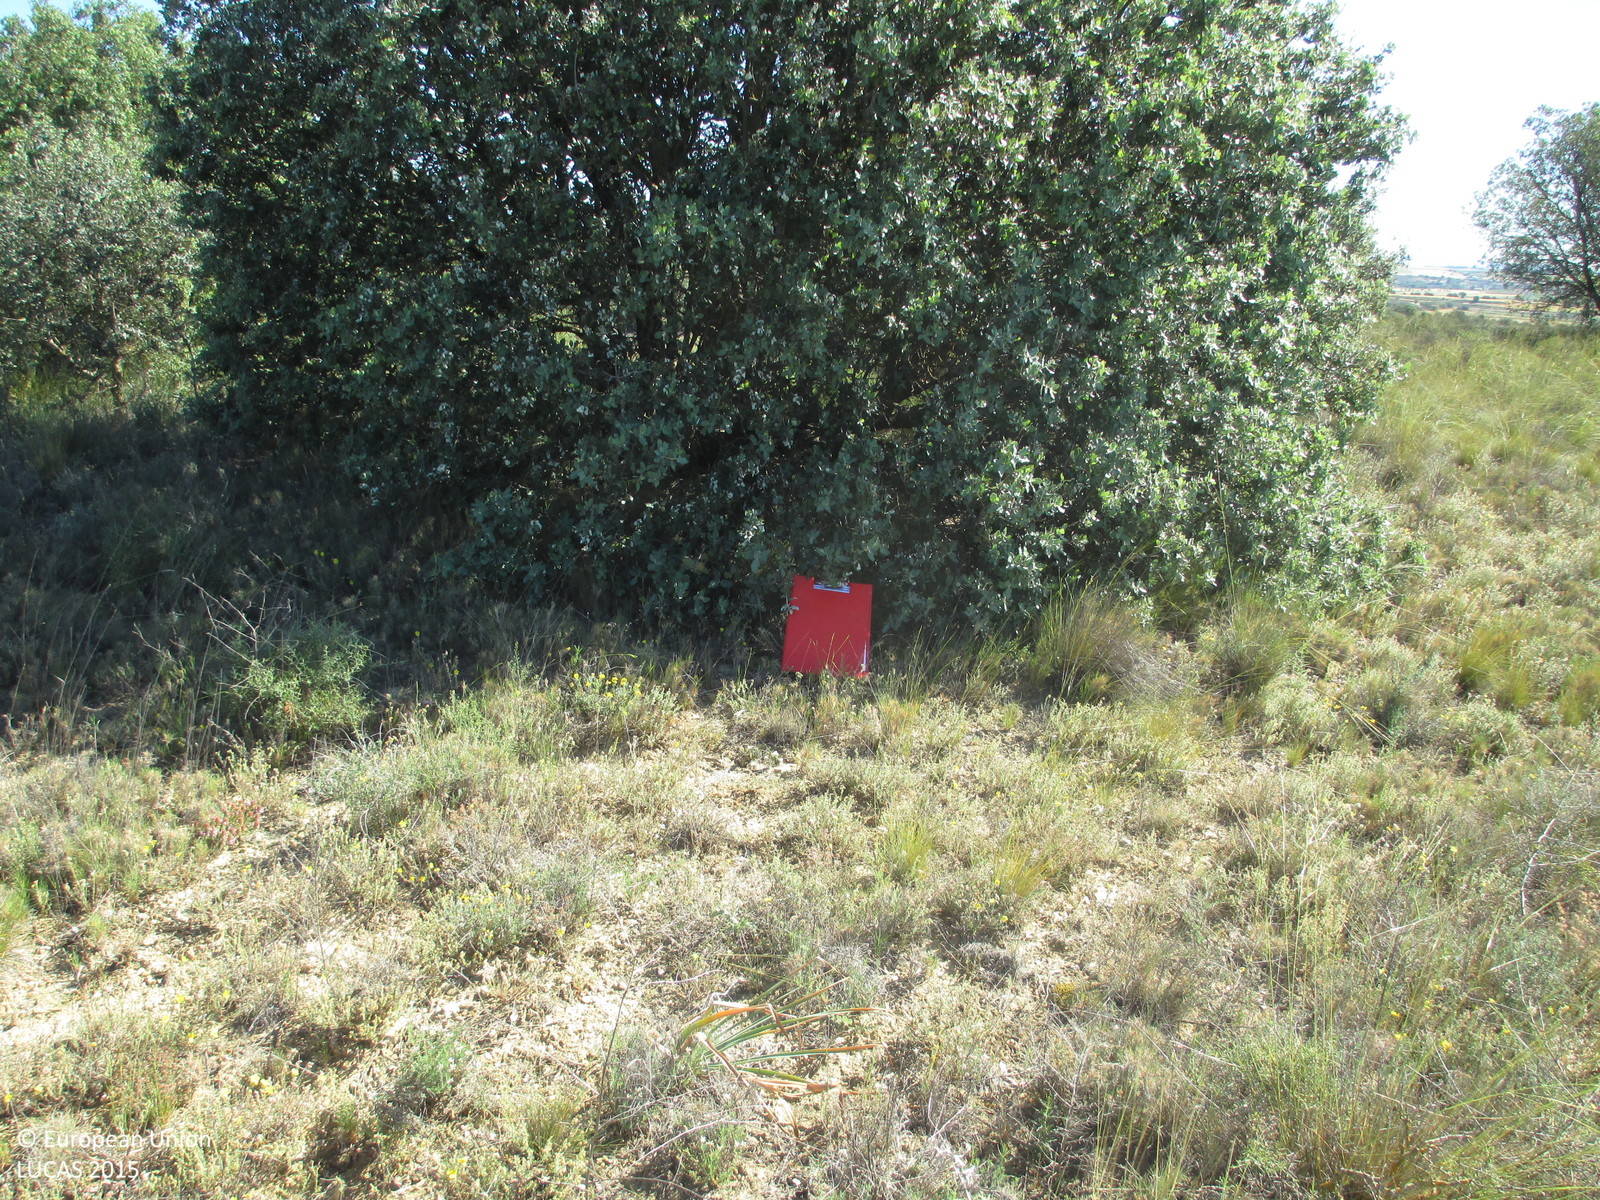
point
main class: Woodland
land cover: Broadleaved woodland
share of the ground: 25 - 50 %
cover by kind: herbaceous plants 50 %, broadleaved forest trees 40 %, shrubs 10 %
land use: Semi-natural and natural areas not in use
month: May
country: ES
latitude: 42.0544
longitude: -0.3038
